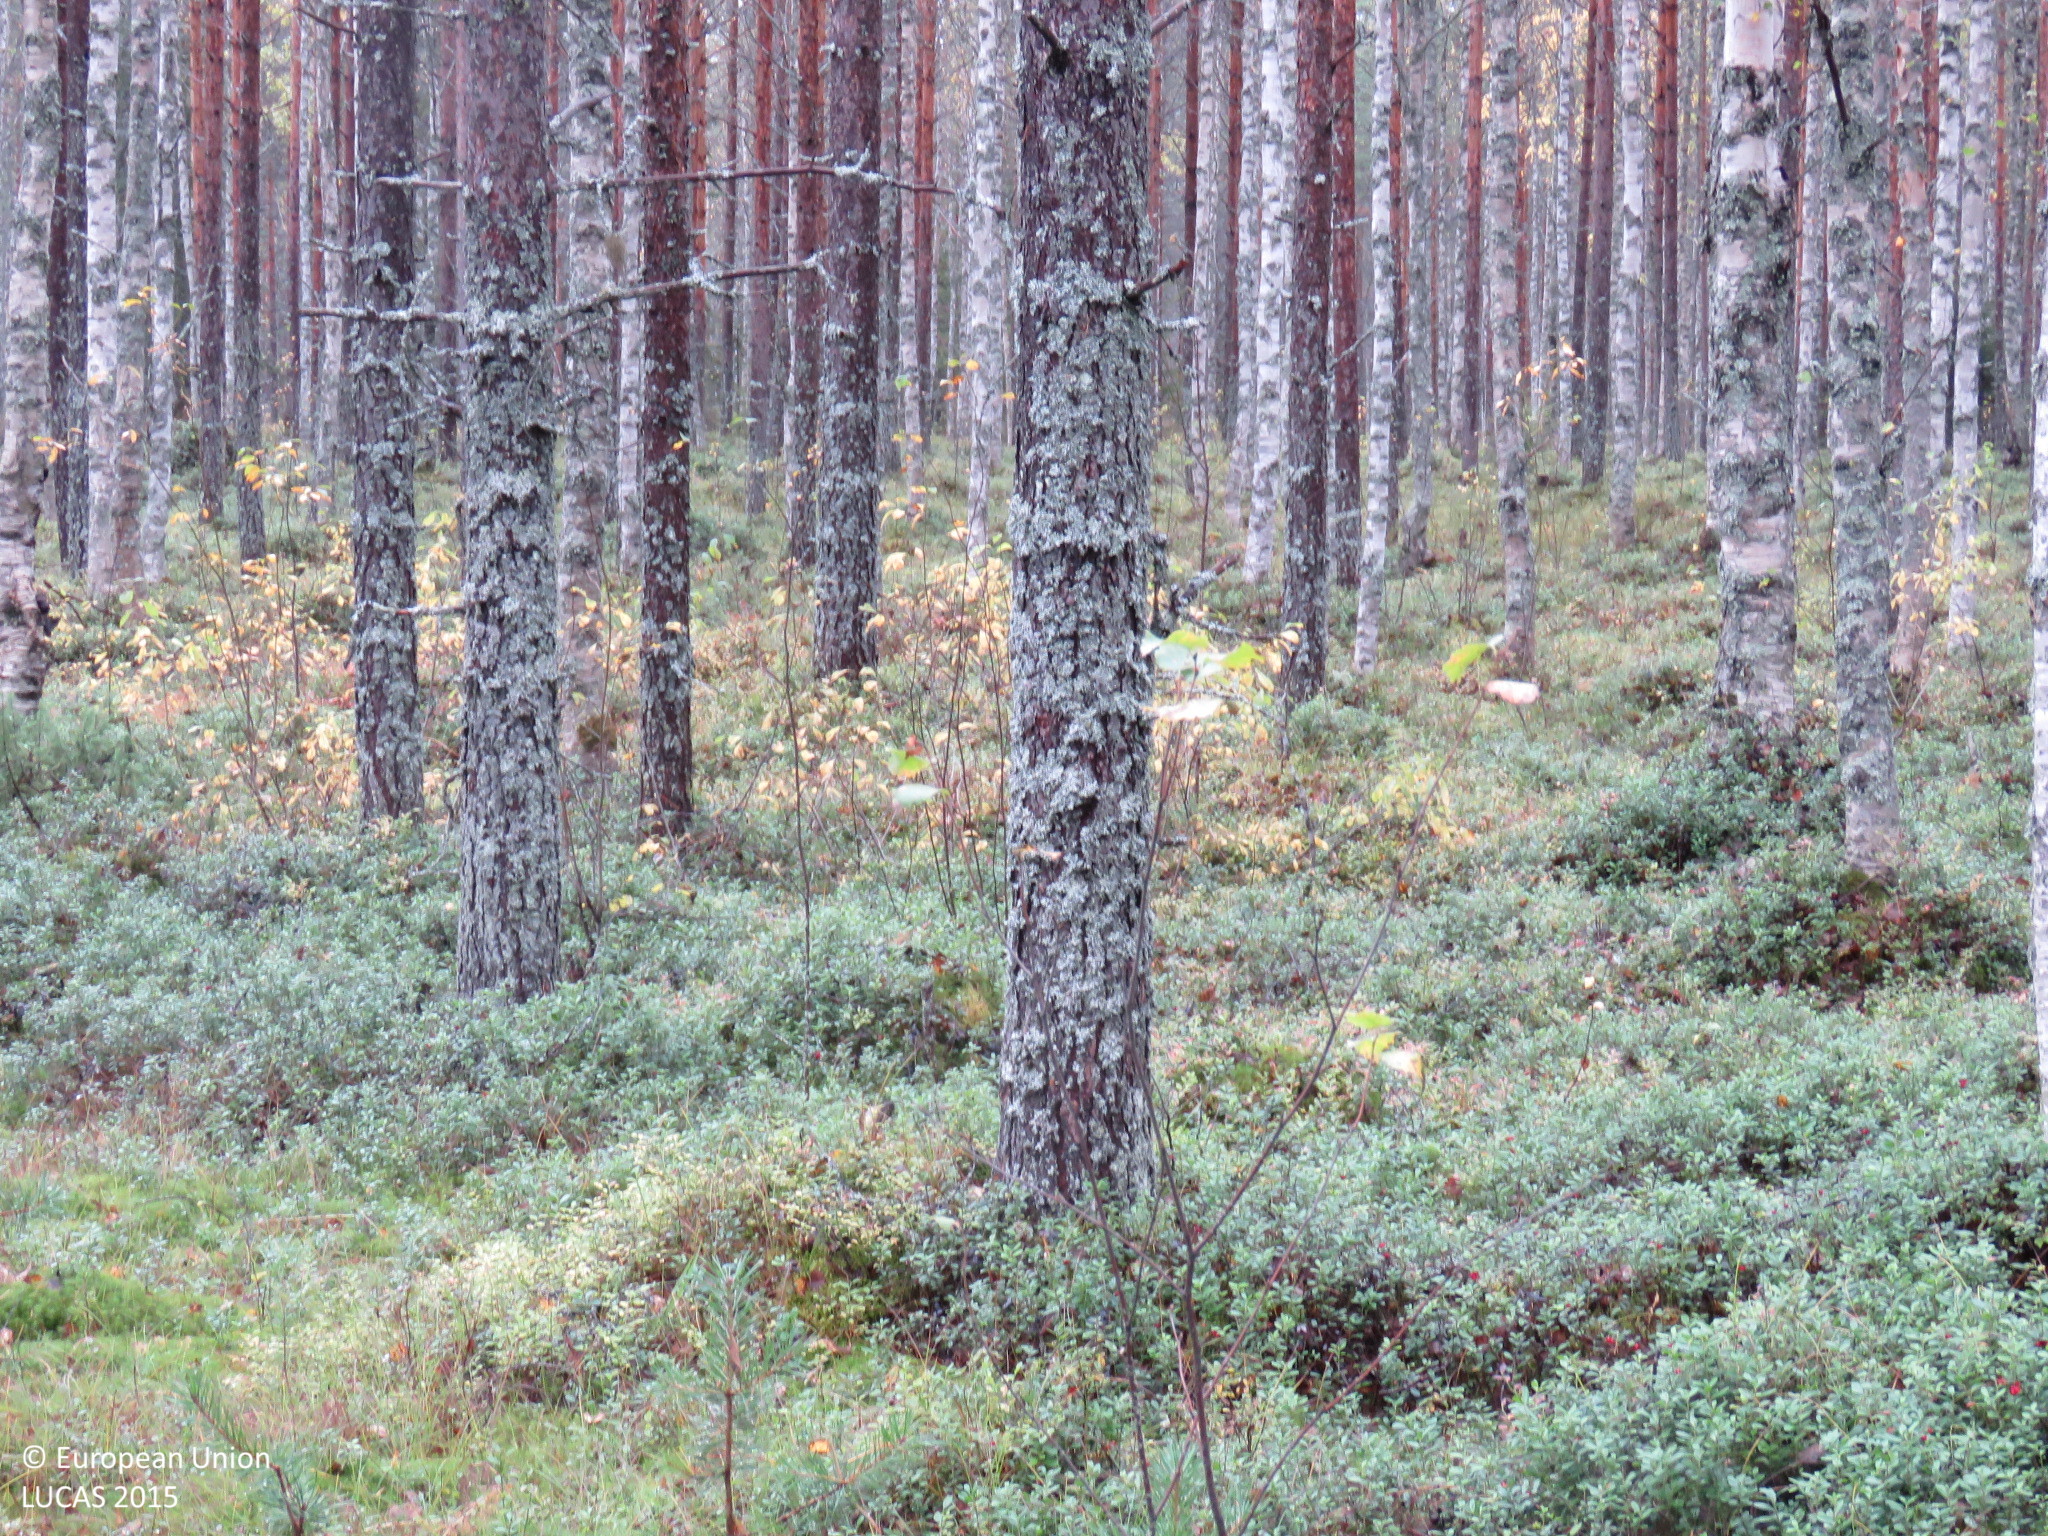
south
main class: Woodland
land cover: Pine dominated mixed woodland
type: boreal forest
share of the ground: 50 - 75 %
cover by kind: broadleaved forest trees 40 %, coniferous forest trees 30 %, shrubs 20 %, herbaceous plants 5 %, lichens and mosses 5 %
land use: Forestry
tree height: > 5 m
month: September
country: FI
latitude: 64.8787
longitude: 26.8604
